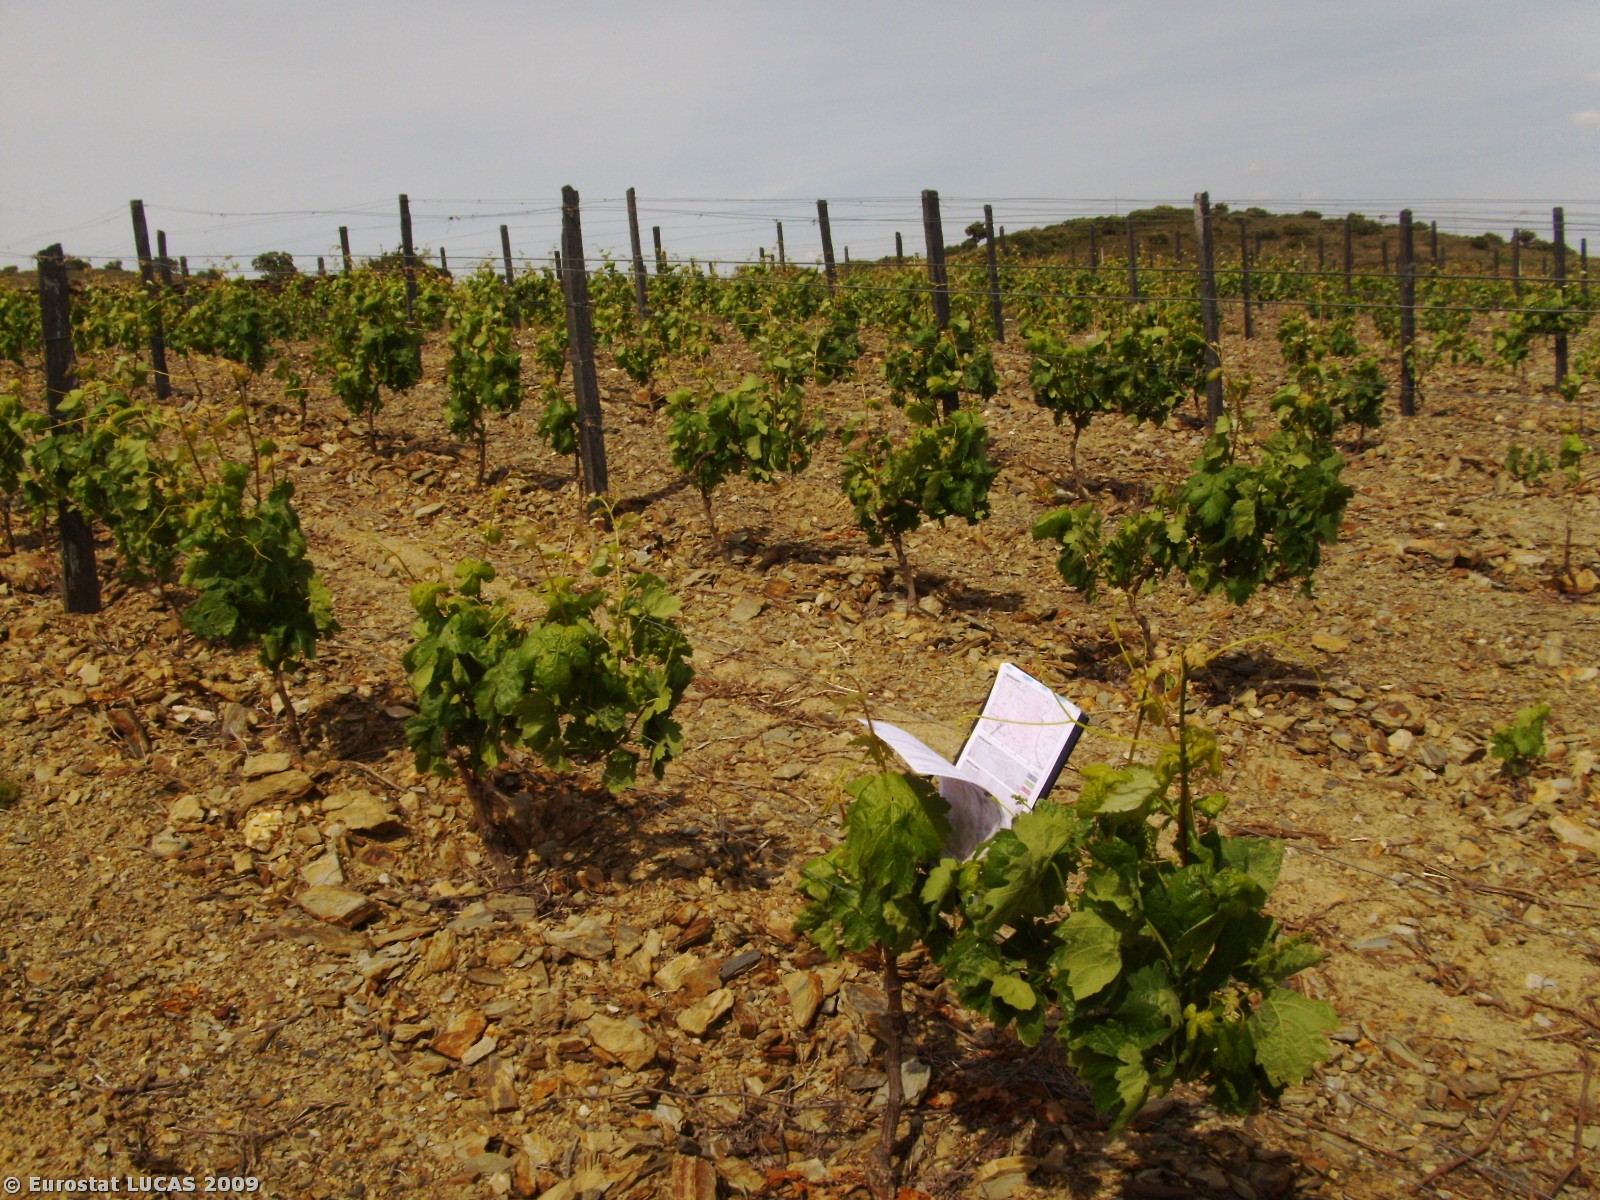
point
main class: Cropland
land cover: Vineyards
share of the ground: 25 - 50 %
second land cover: Bare land
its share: 50 - 75 %
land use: Agriculture (excluding fallow land and kitchen gardens)
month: May
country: PT
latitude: 41.1335
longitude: -7.4041
